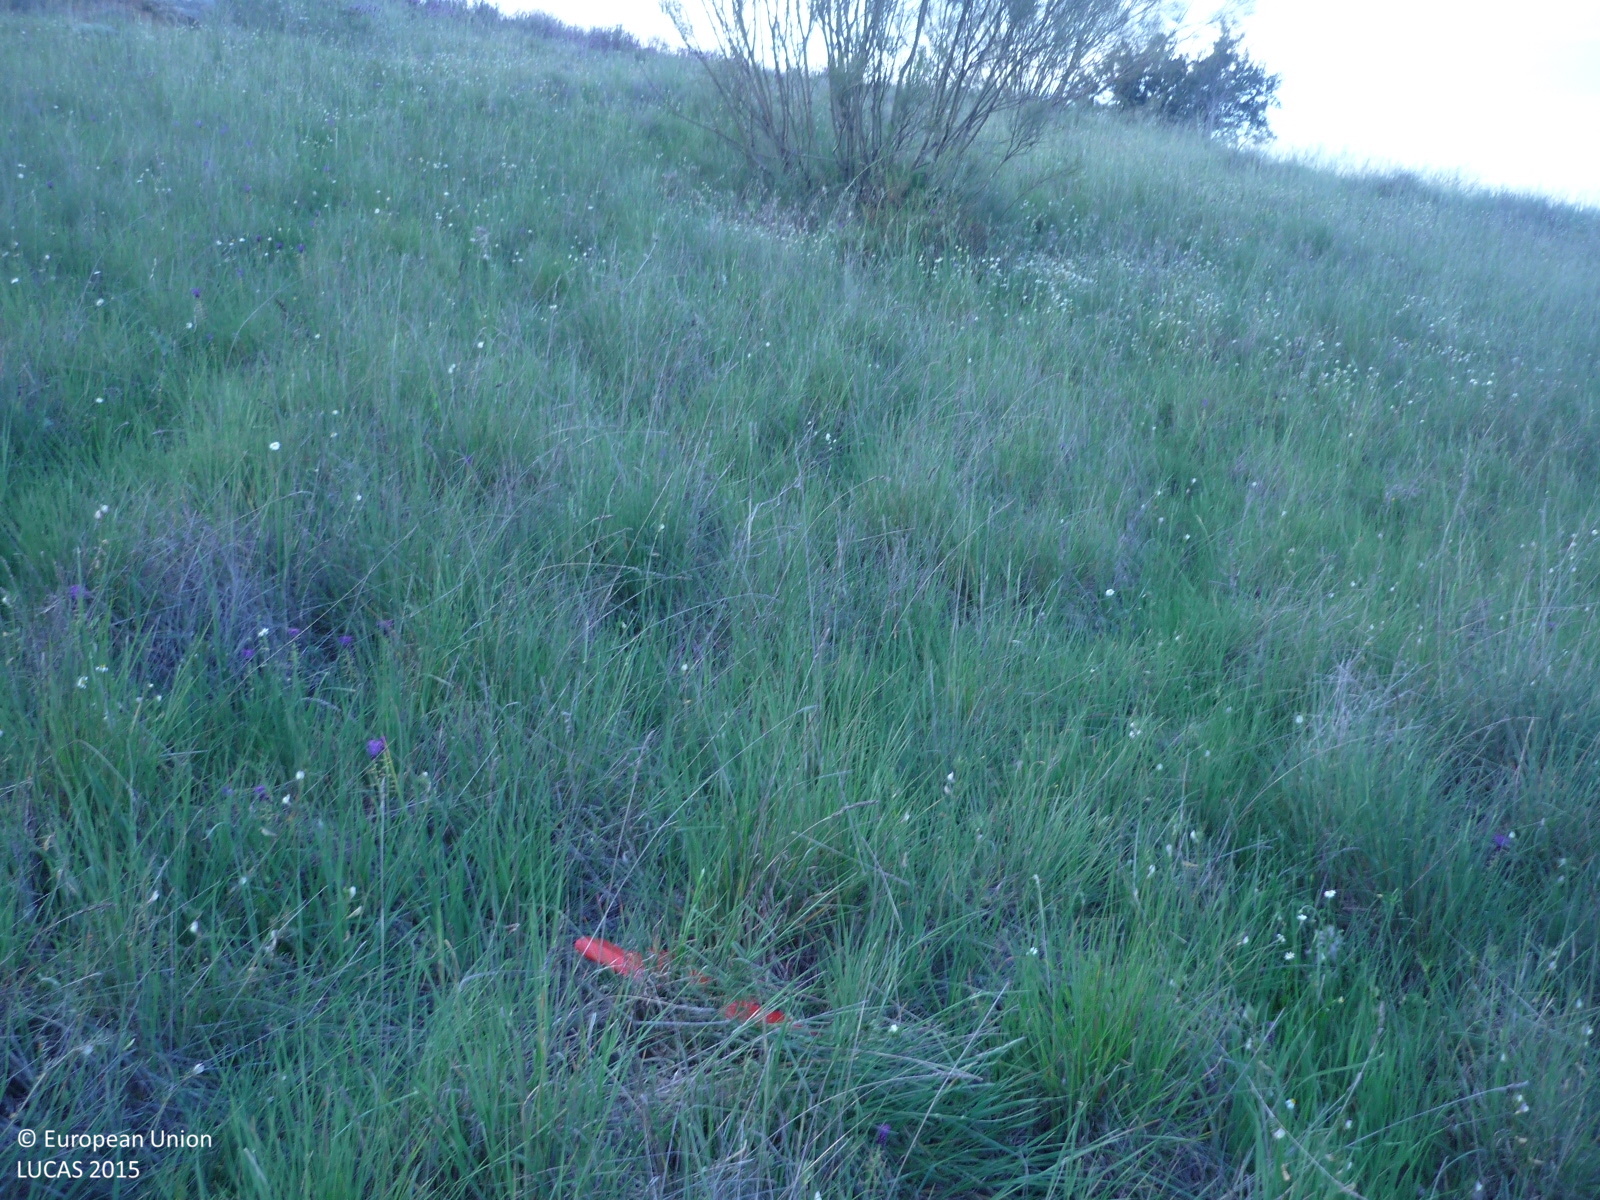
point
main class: Grassland
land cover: Grassland with sparse tree/shrub cover
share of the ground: > 75 %
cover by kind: herbaceous plants 85 %, shrubs 10 %, broadleaved forest trees 5 %
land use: Agriculture (excluding fallow land and kitchen gardens)
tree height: < 5 m
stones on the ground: < 10 %
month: April
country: ES
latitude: 40.7083
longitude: -3.5925
